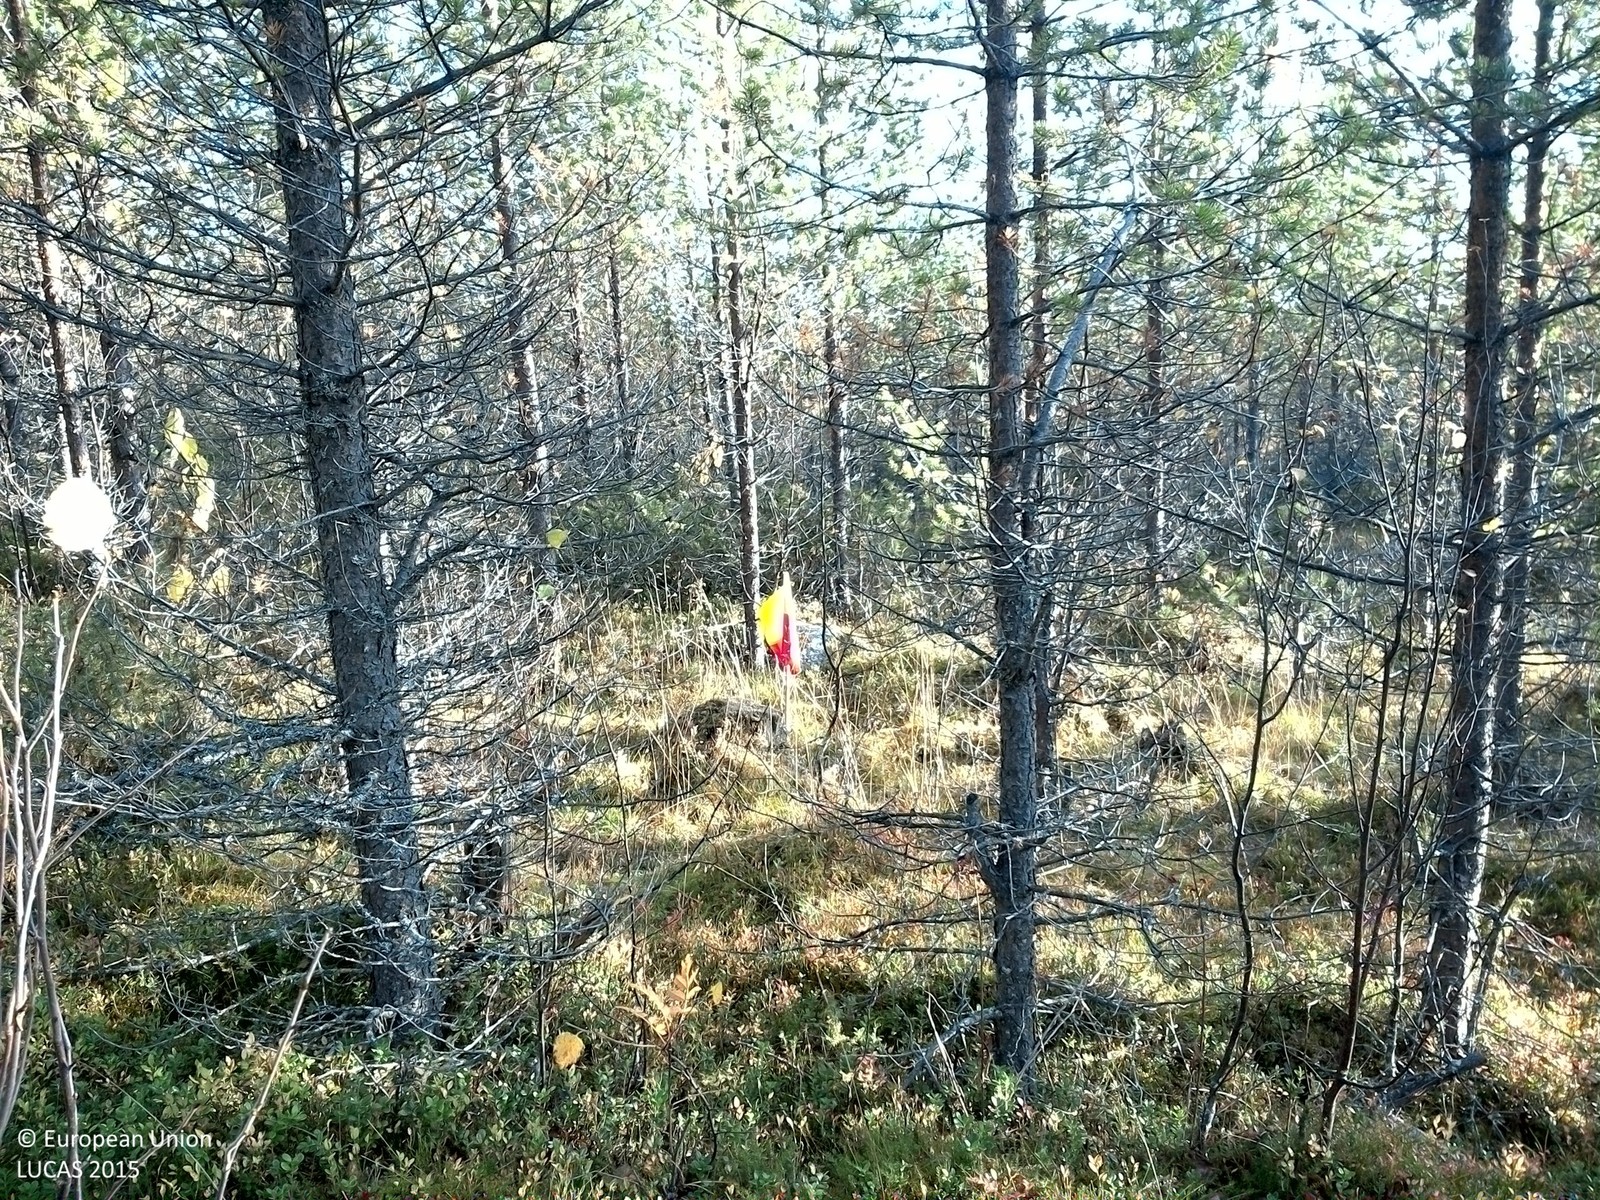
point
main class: Woodland
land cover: Pine dominated coniferous woodland
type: boreal forest
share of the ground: 50 - 75 %
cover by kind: coniferous forest trees 50 %, shrubs 35 %, lichens and mosses 10 %, herbaceous plants 5 %
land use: Forestry
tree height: > 5 m
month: October
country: SE
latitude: 64.4038
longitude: 15.7166
